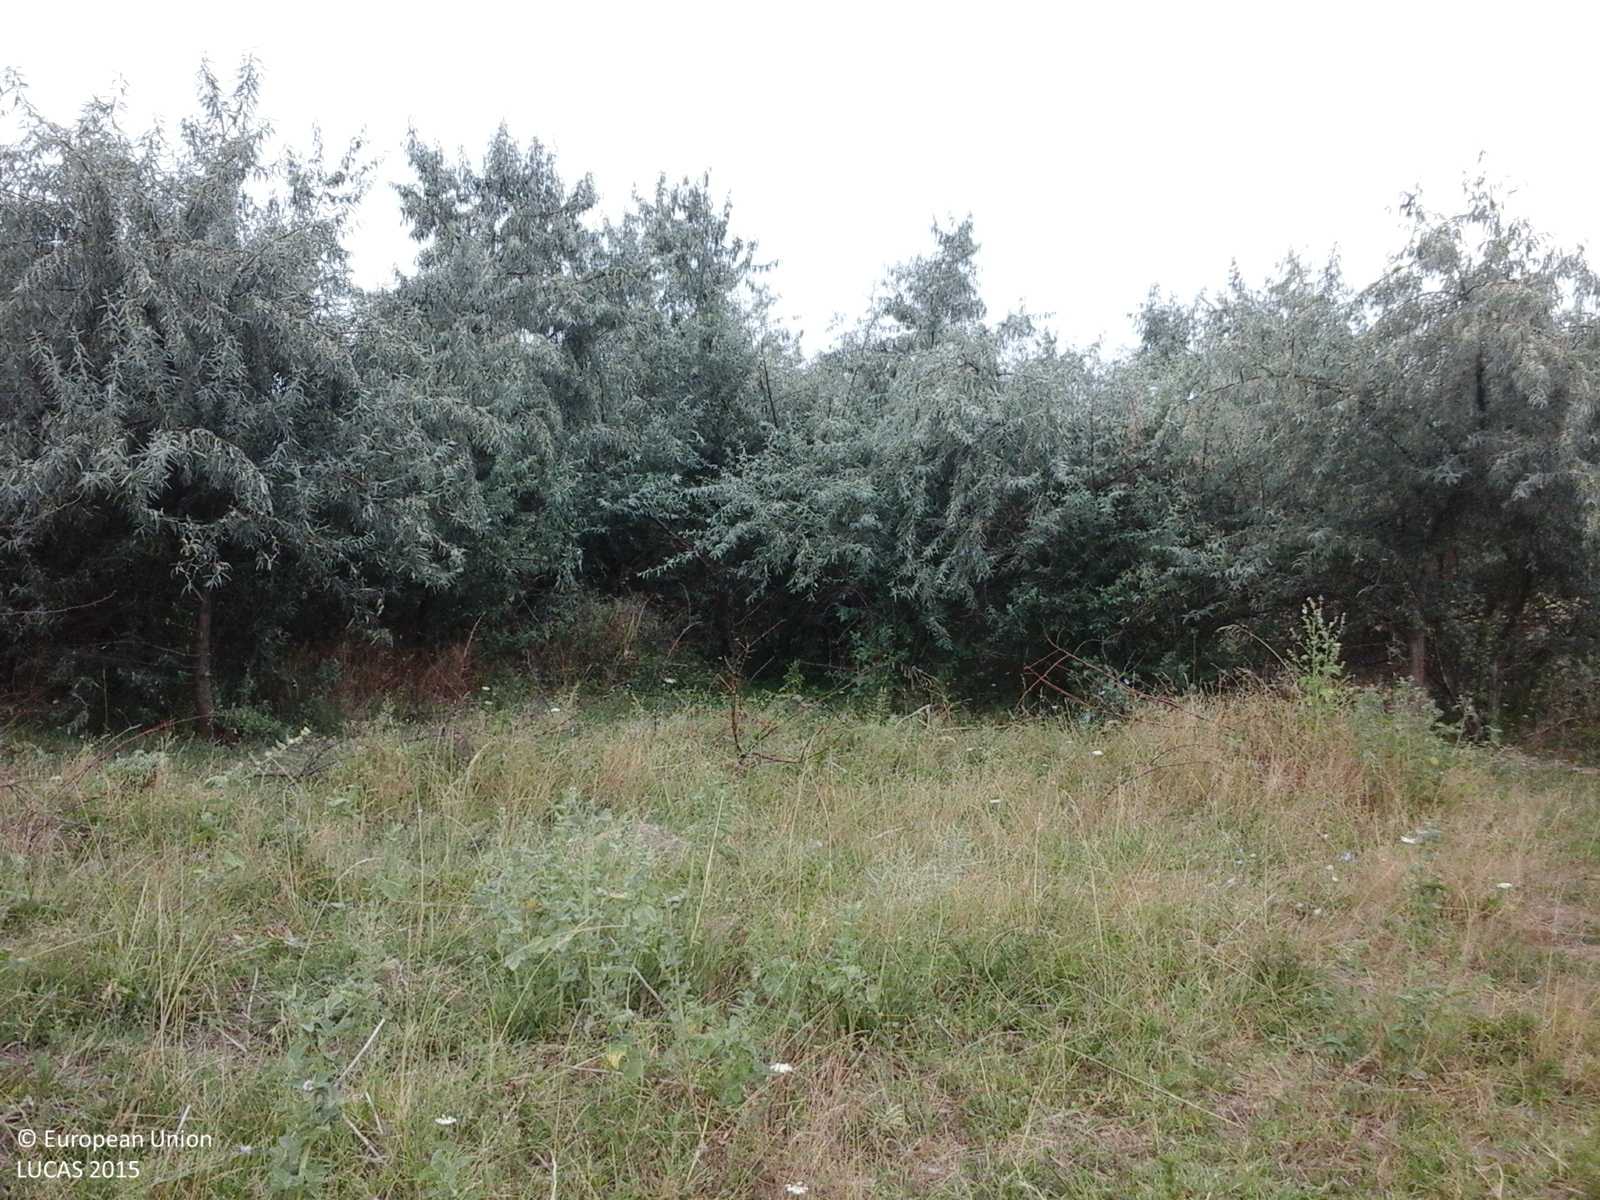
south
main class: Grassland
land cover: Grassland with sparse tree/shrub cover
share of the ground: > 75 %
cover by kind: herbaceous plants 85 %, shrubs 10 %, broadleaved forest trees 5 %
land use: Semi-natural and natural areas not in use
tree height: > 5 m
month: July
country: RO
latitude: 45.0645
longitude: 28.2180
